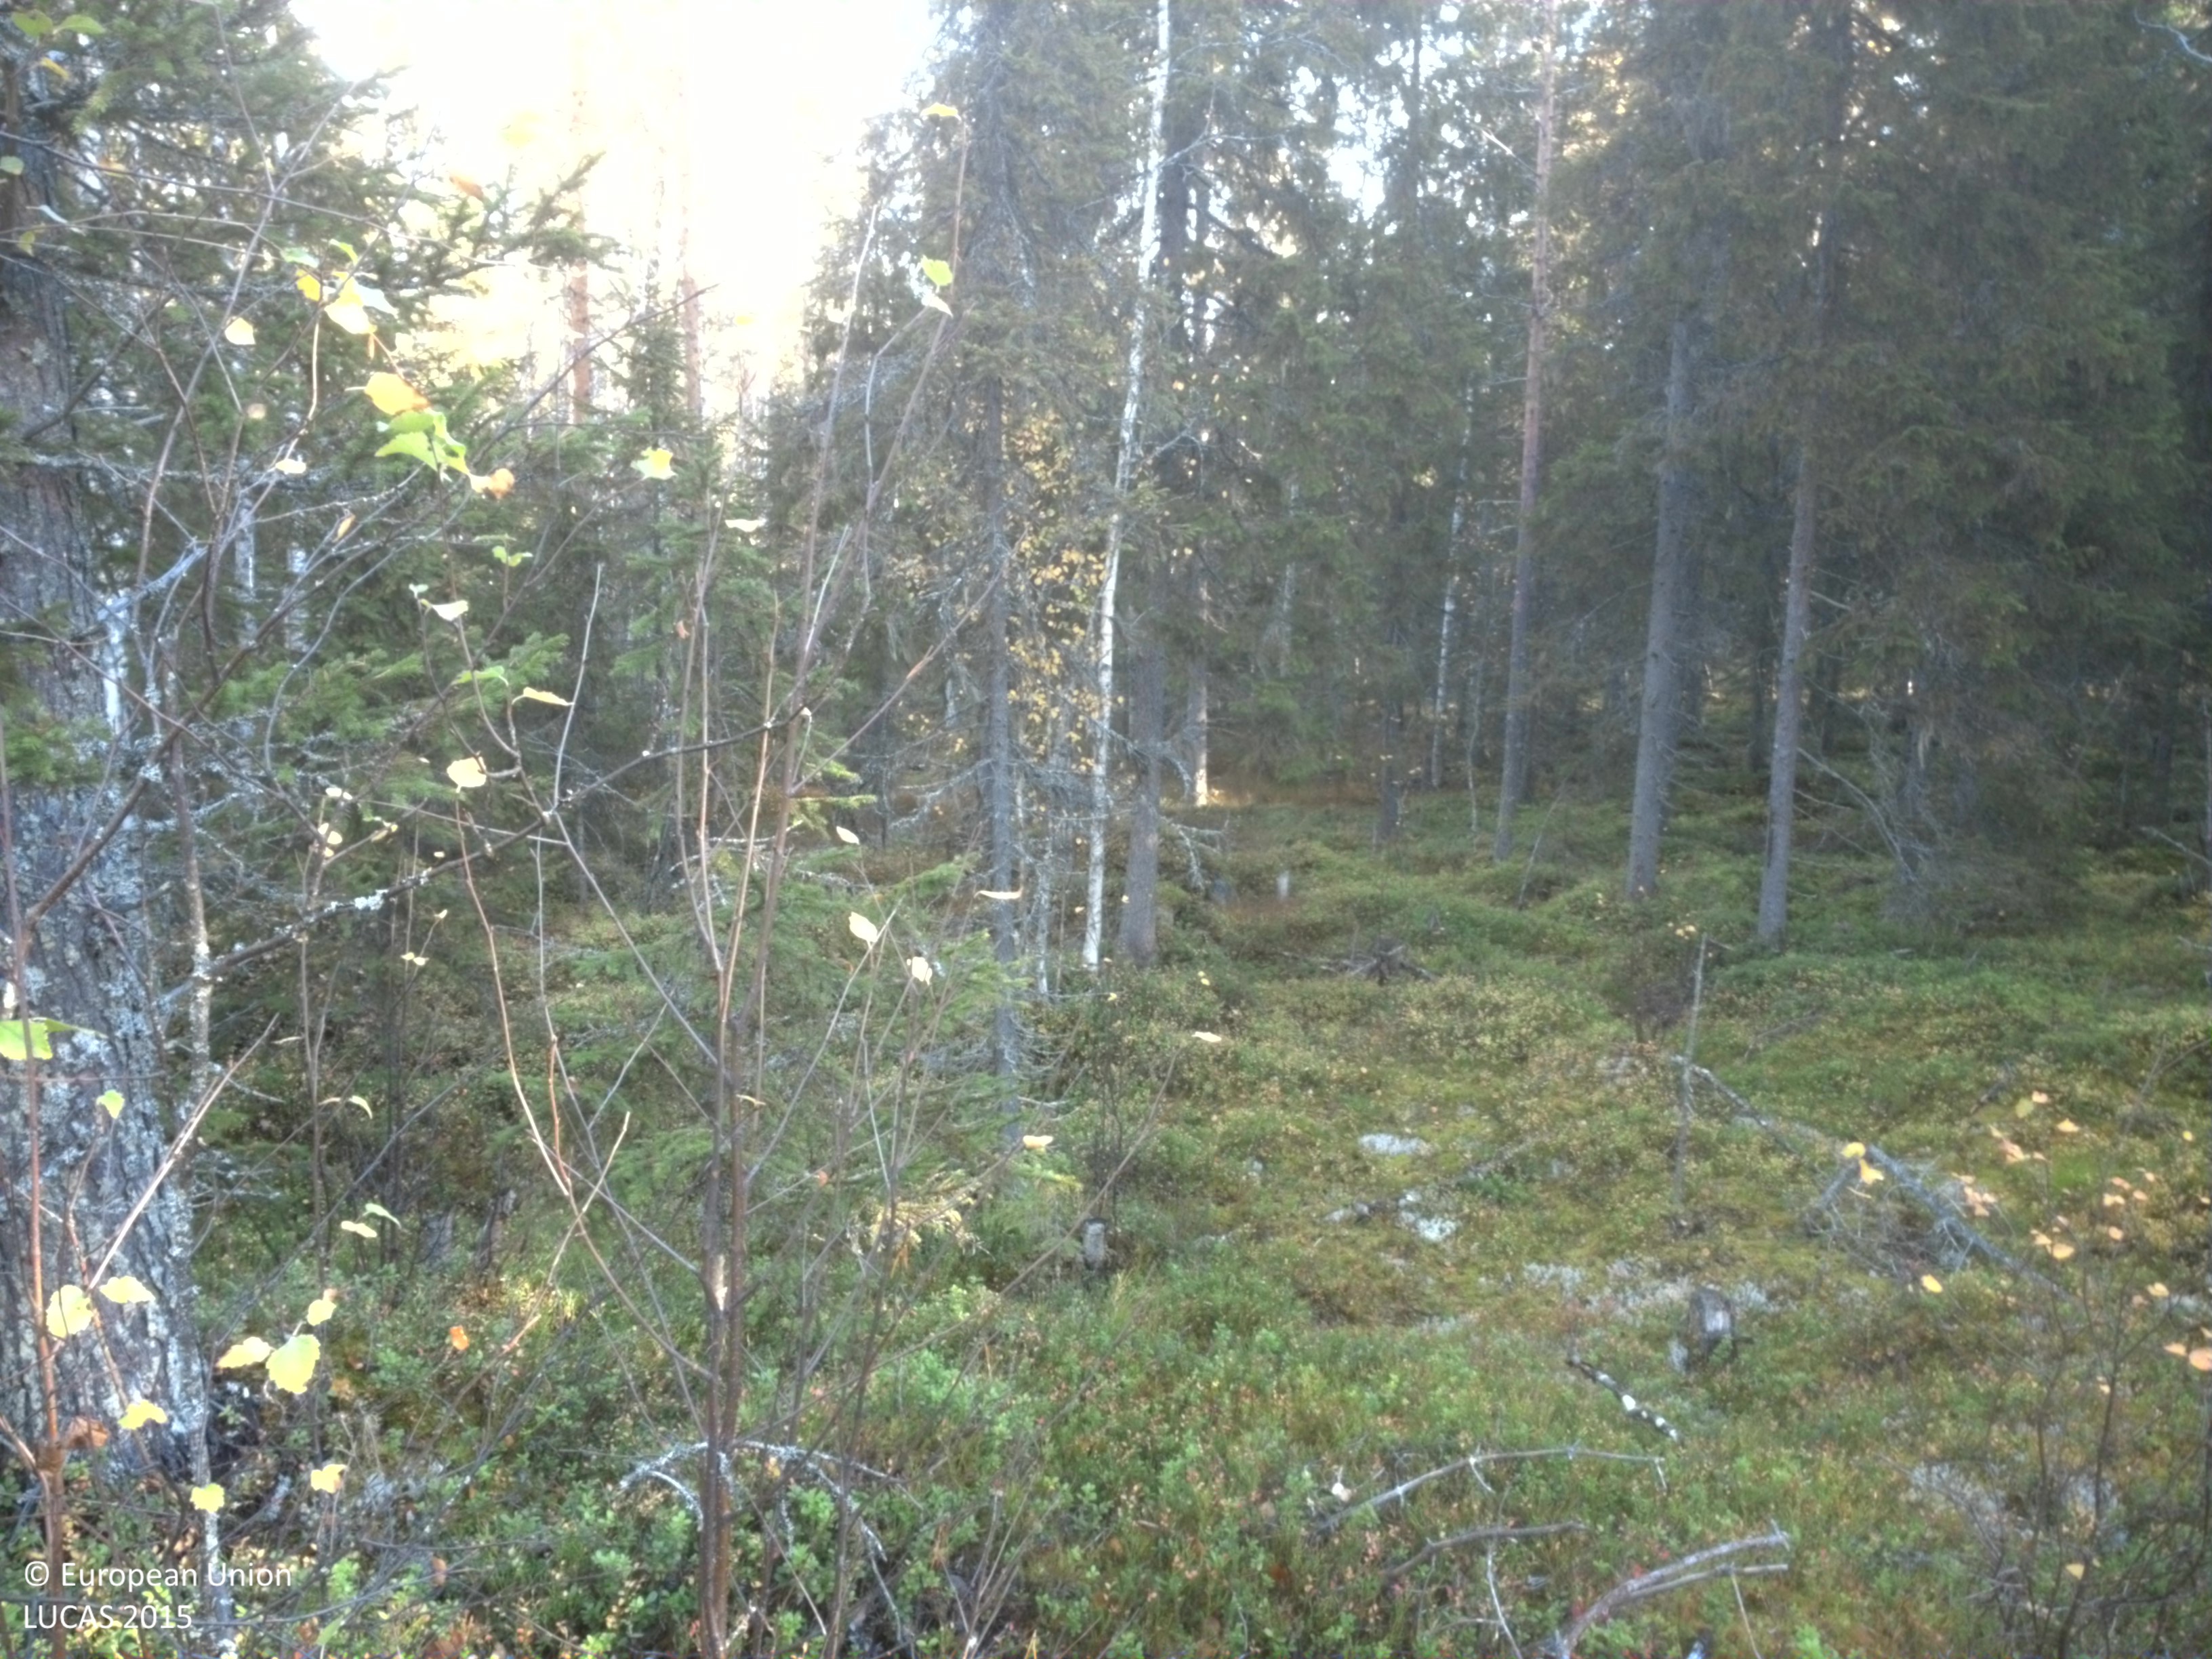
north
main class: Woodland
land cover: Other mixed woodland
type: boreal forest
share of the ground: 50 - 75 %
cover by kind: coniferous forest trees 35 %, shrubs 25 %, broadleaved forest trees 20 %, lichens and mosses 20 %
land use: Forestry
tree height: > 5 m
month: September
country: SE
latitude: 64.2089
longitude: 20.0089
